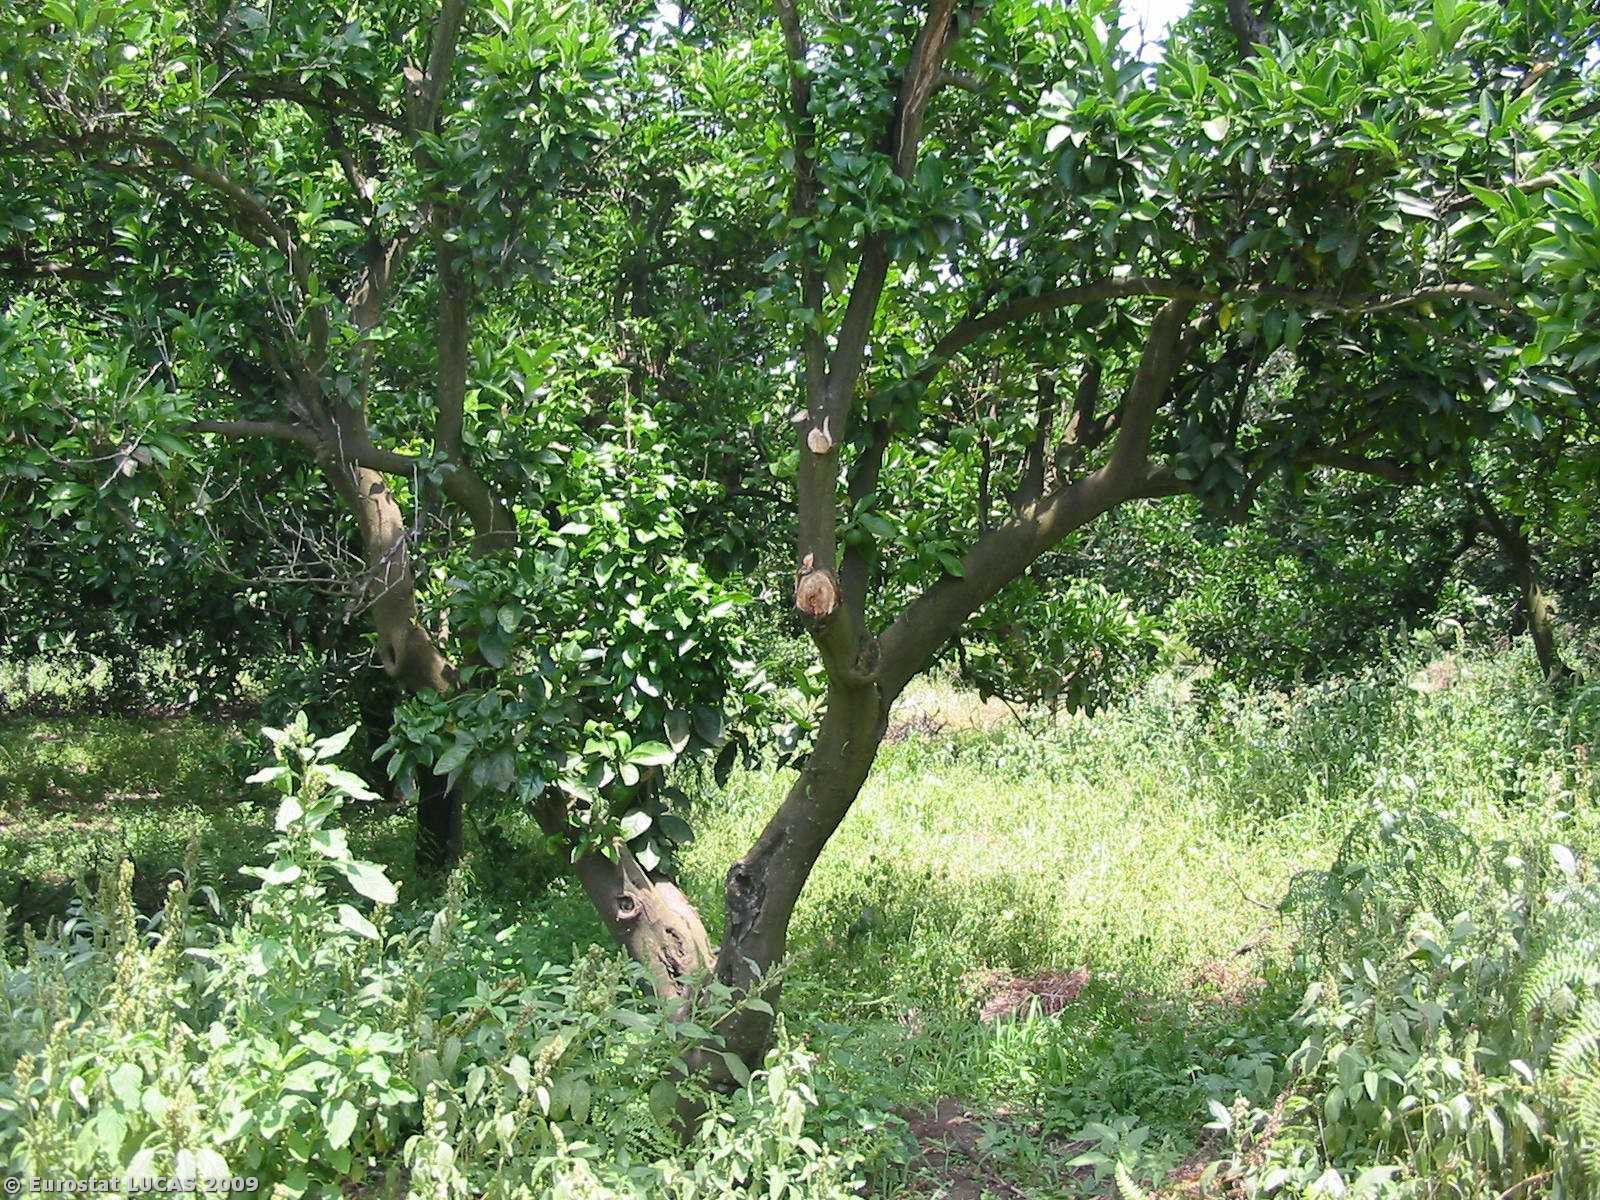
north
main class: Cropland
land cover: Oranges
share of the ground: 50 - 75 %
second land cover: Spontaneously vegetated surfaces
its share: 50 - 75 %
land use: Agriculture (excluding fallow land and kitchen gardens)
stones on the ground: < 10 %
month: July
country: IT
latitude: 38.5240
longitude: 15.9644
